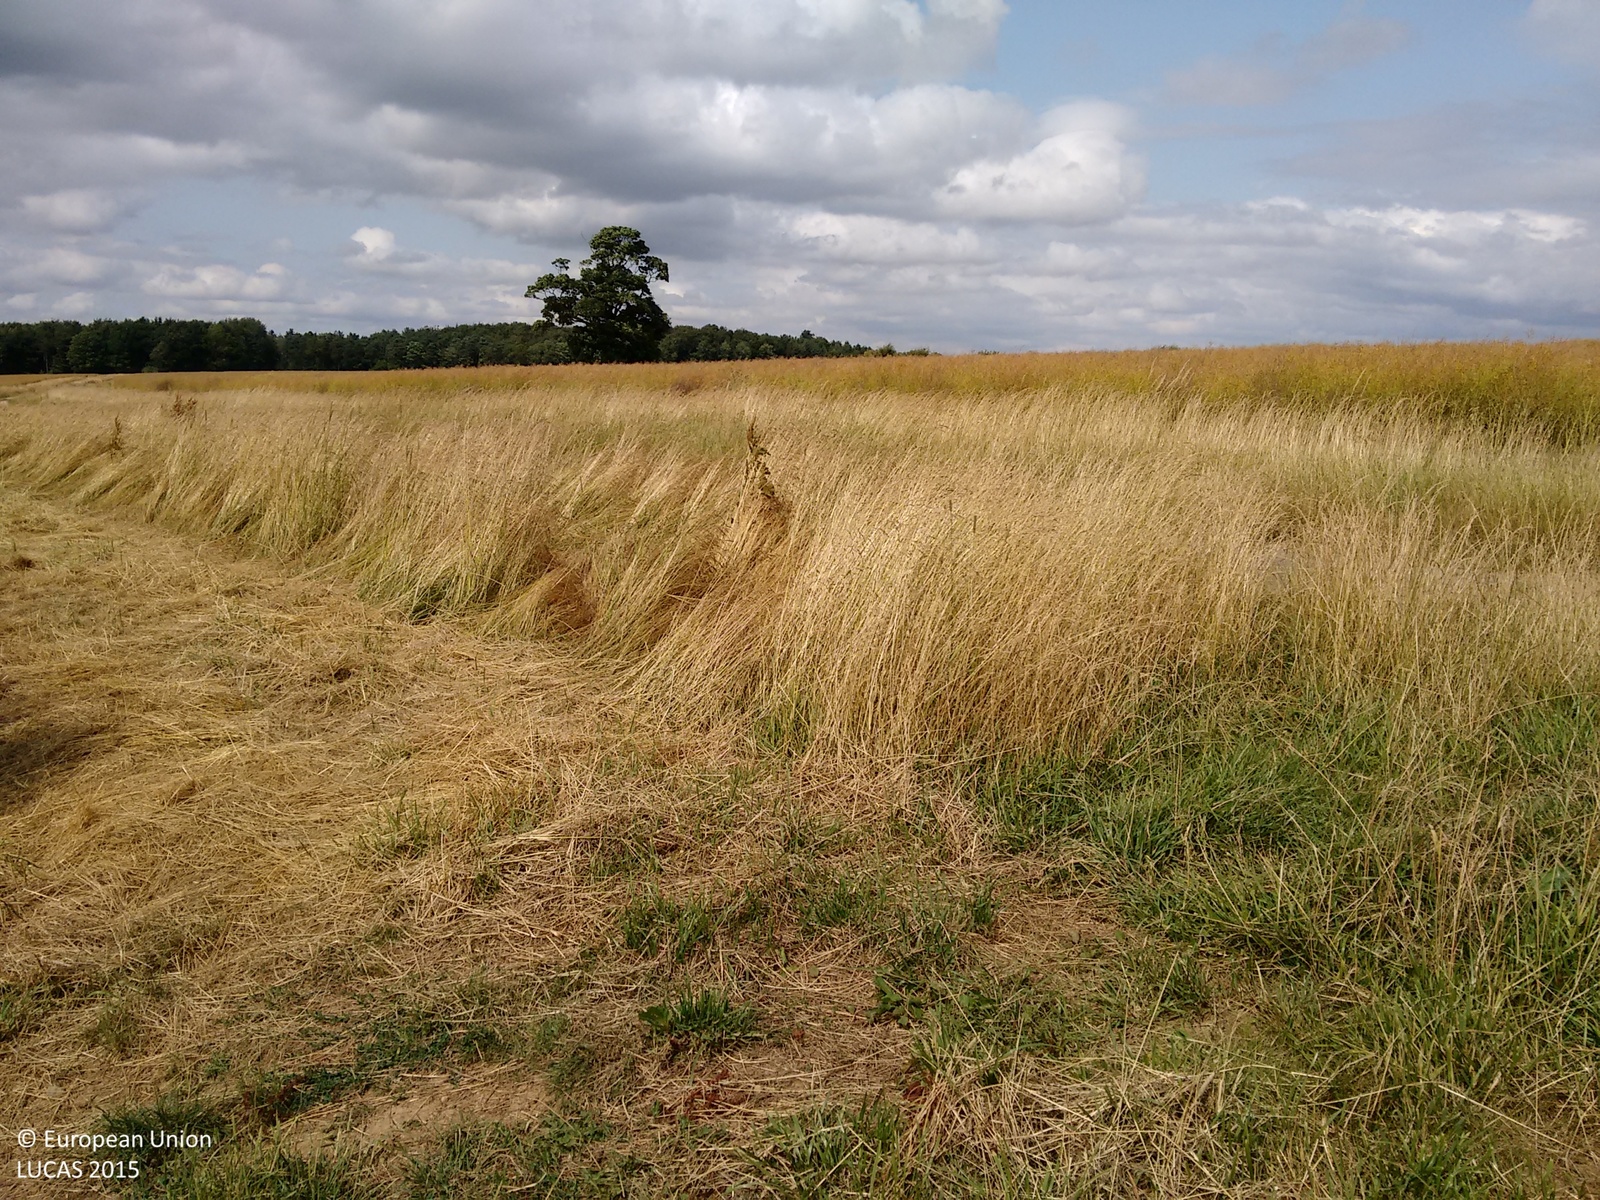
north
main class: Cropland
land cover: Rape and turnip rape
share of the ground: > 75 %
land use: Agriculture (excluding fallow land and kitchen gardens)
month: July
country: GB
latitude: 52.7004
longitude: -0.5902
